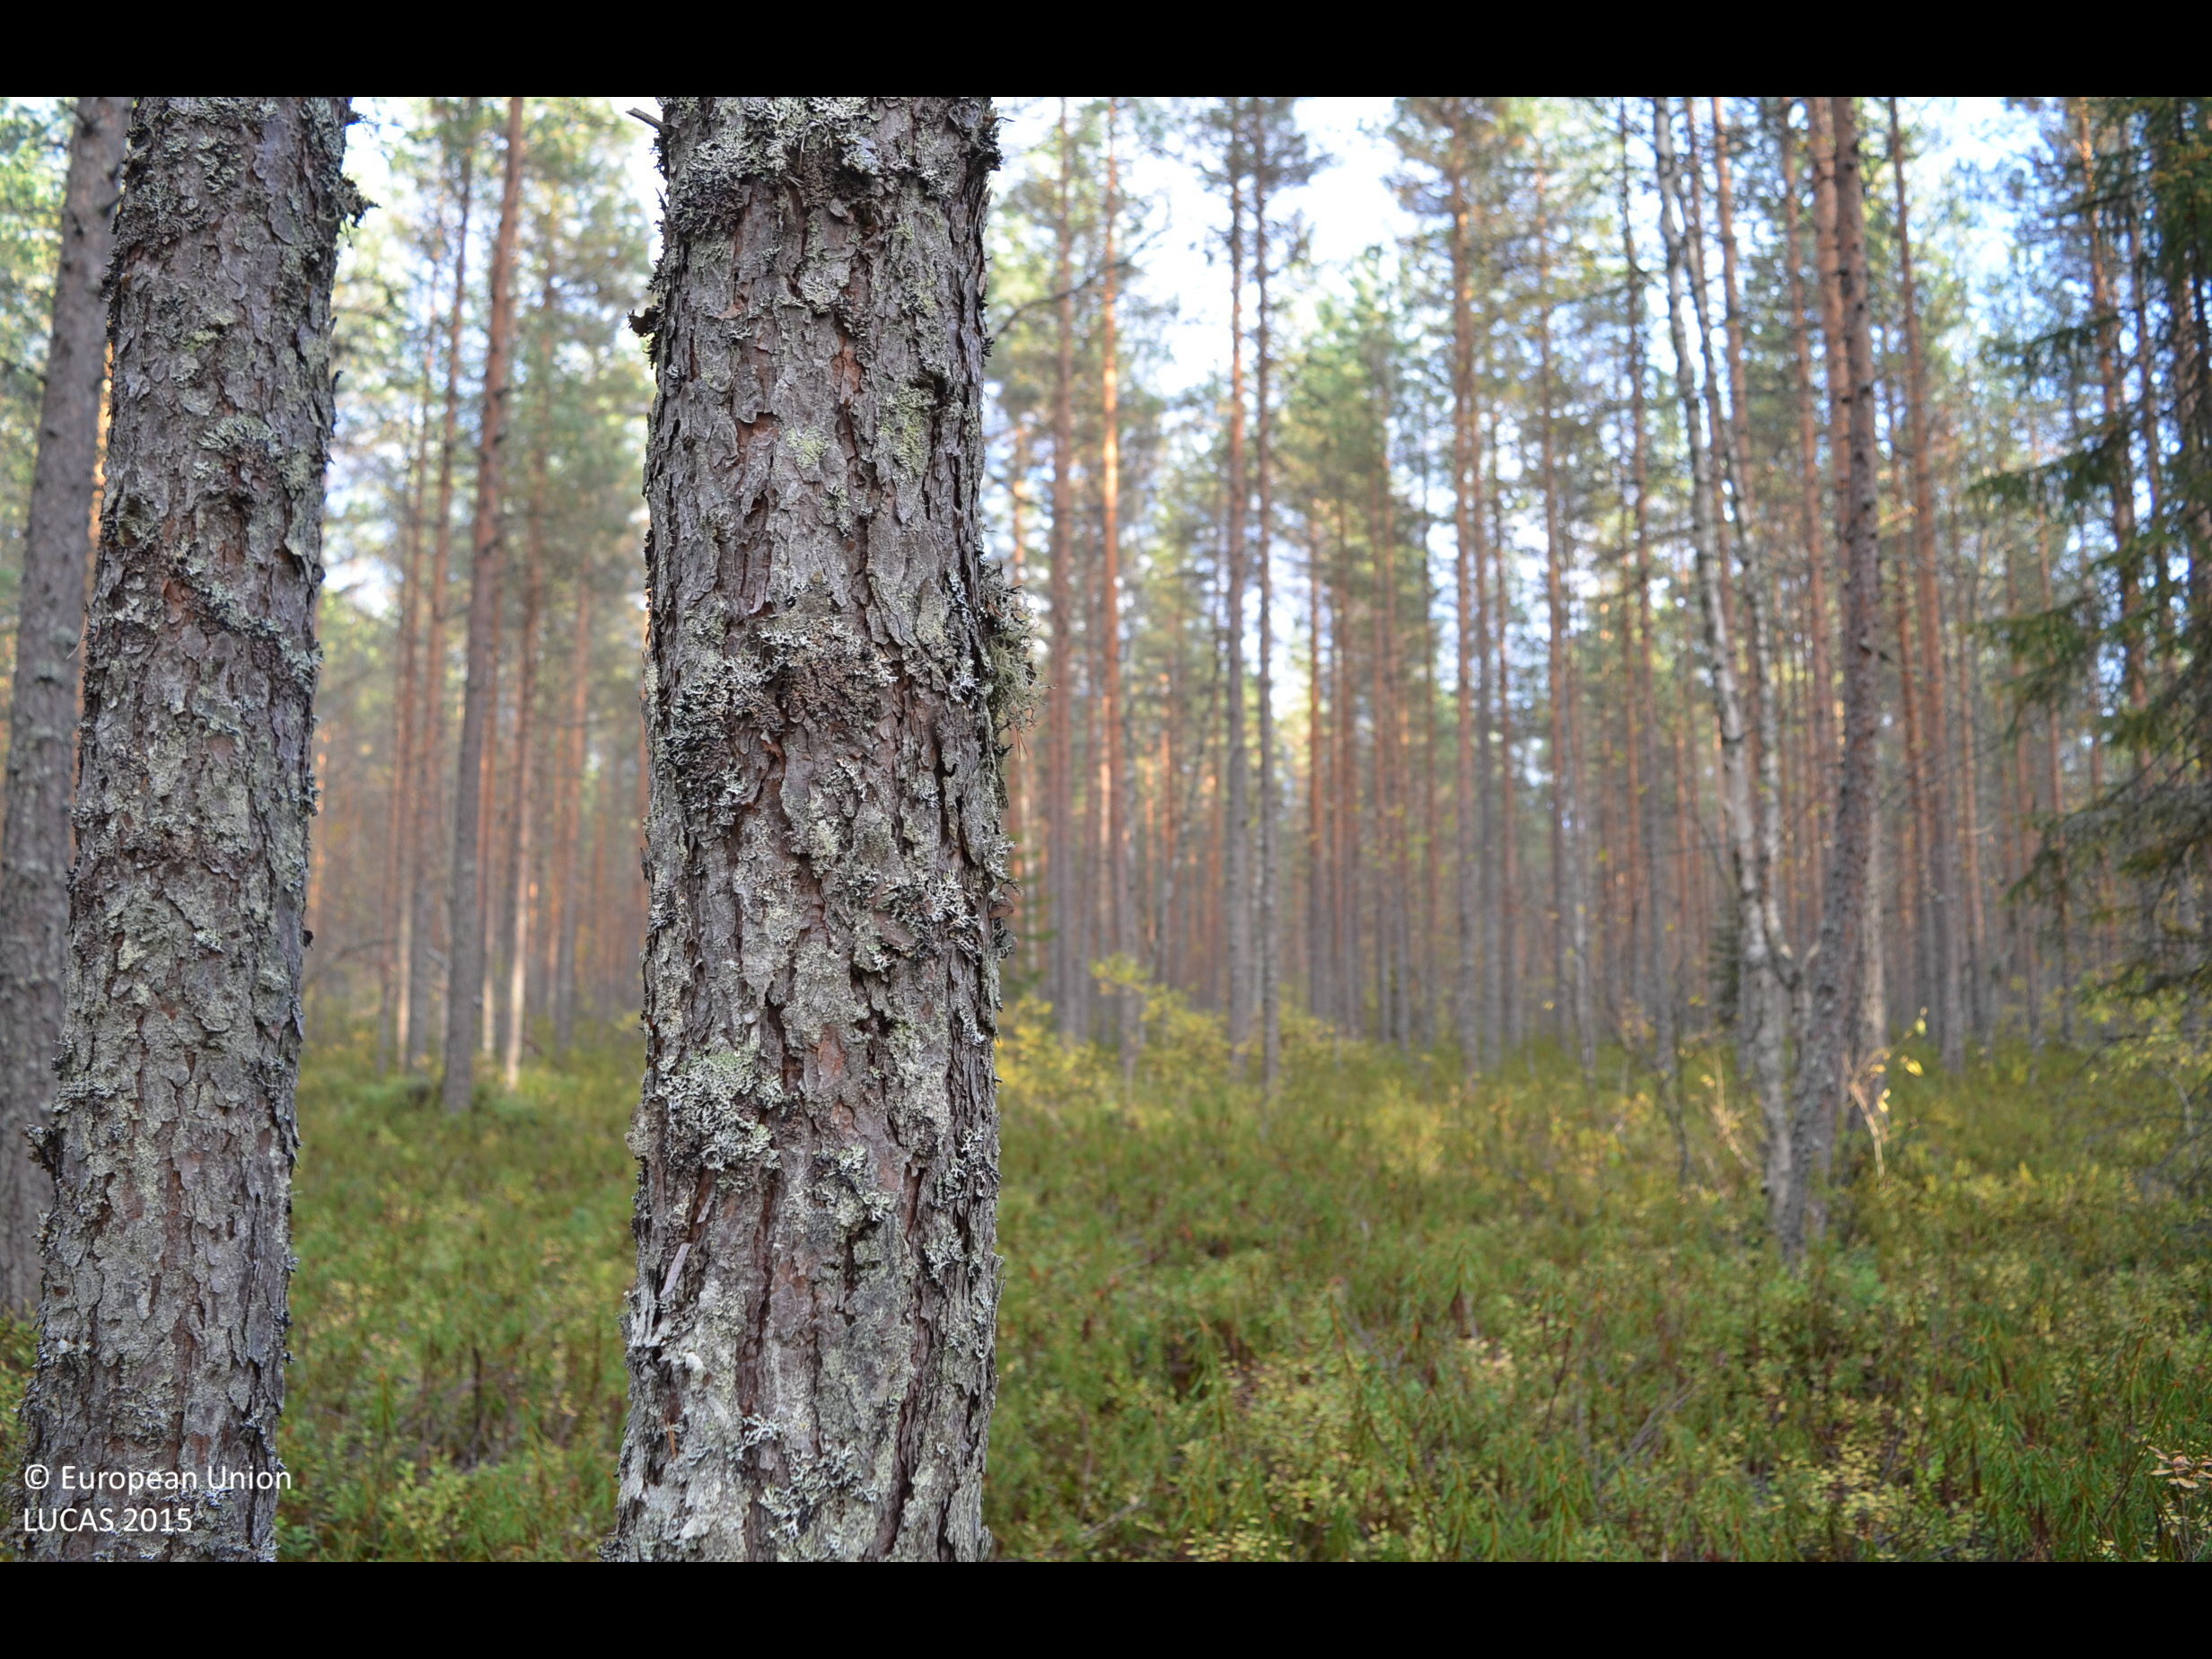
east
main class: Woodland
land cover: Pine dominated coniferous woodland
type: boreal forest
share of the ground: > 75 %
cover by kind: coniferous forest trees 70 %, shrubs 25 %, broadleaved forest trees 5 %
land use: Forestry
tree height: > 5 m
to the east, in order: Pine dominated coniferous woodland; Ditches and canals; Pine dominated coniferous woodland; Ditches and canals; Pine dominated coniferous woodland; Ditches and canals; Pine dominated coniferous woodland; Ditches and canals; Pine dominated coniferous woodland; Ditches and canals; Pine dominated coniferous woodland; Ditches and canals; Pine dominated coniferous woodland
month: October
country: FI
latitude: 62.3672
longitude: 23.5044
